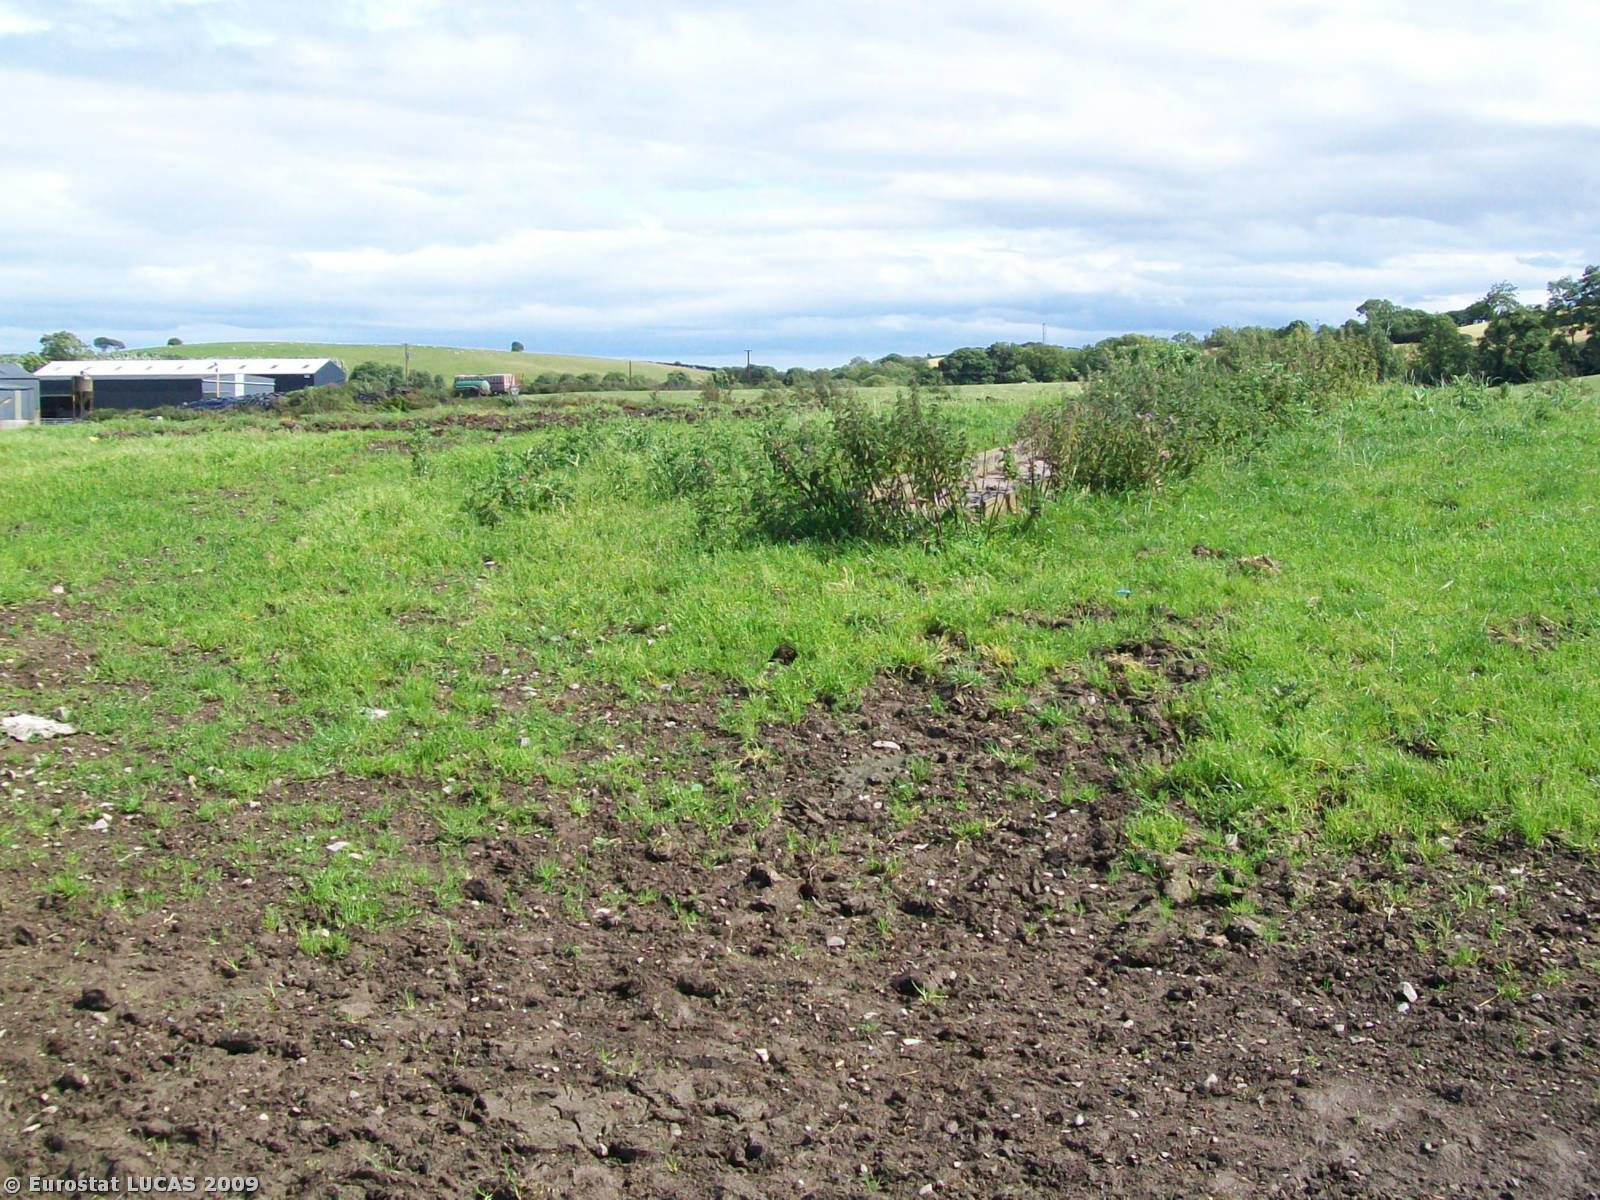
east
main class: Grassland
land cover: Grassland without tree/shrub cover
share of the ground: > 75 %
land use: Agriculture (excluding fallow land and kitchen gardens)
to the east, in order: Grassland without tree/shrub cover; Fences; Abandoned hedges; Grassland without tree/shrub cover
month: August
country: GB
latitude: 54.4425
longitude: -5.6911
